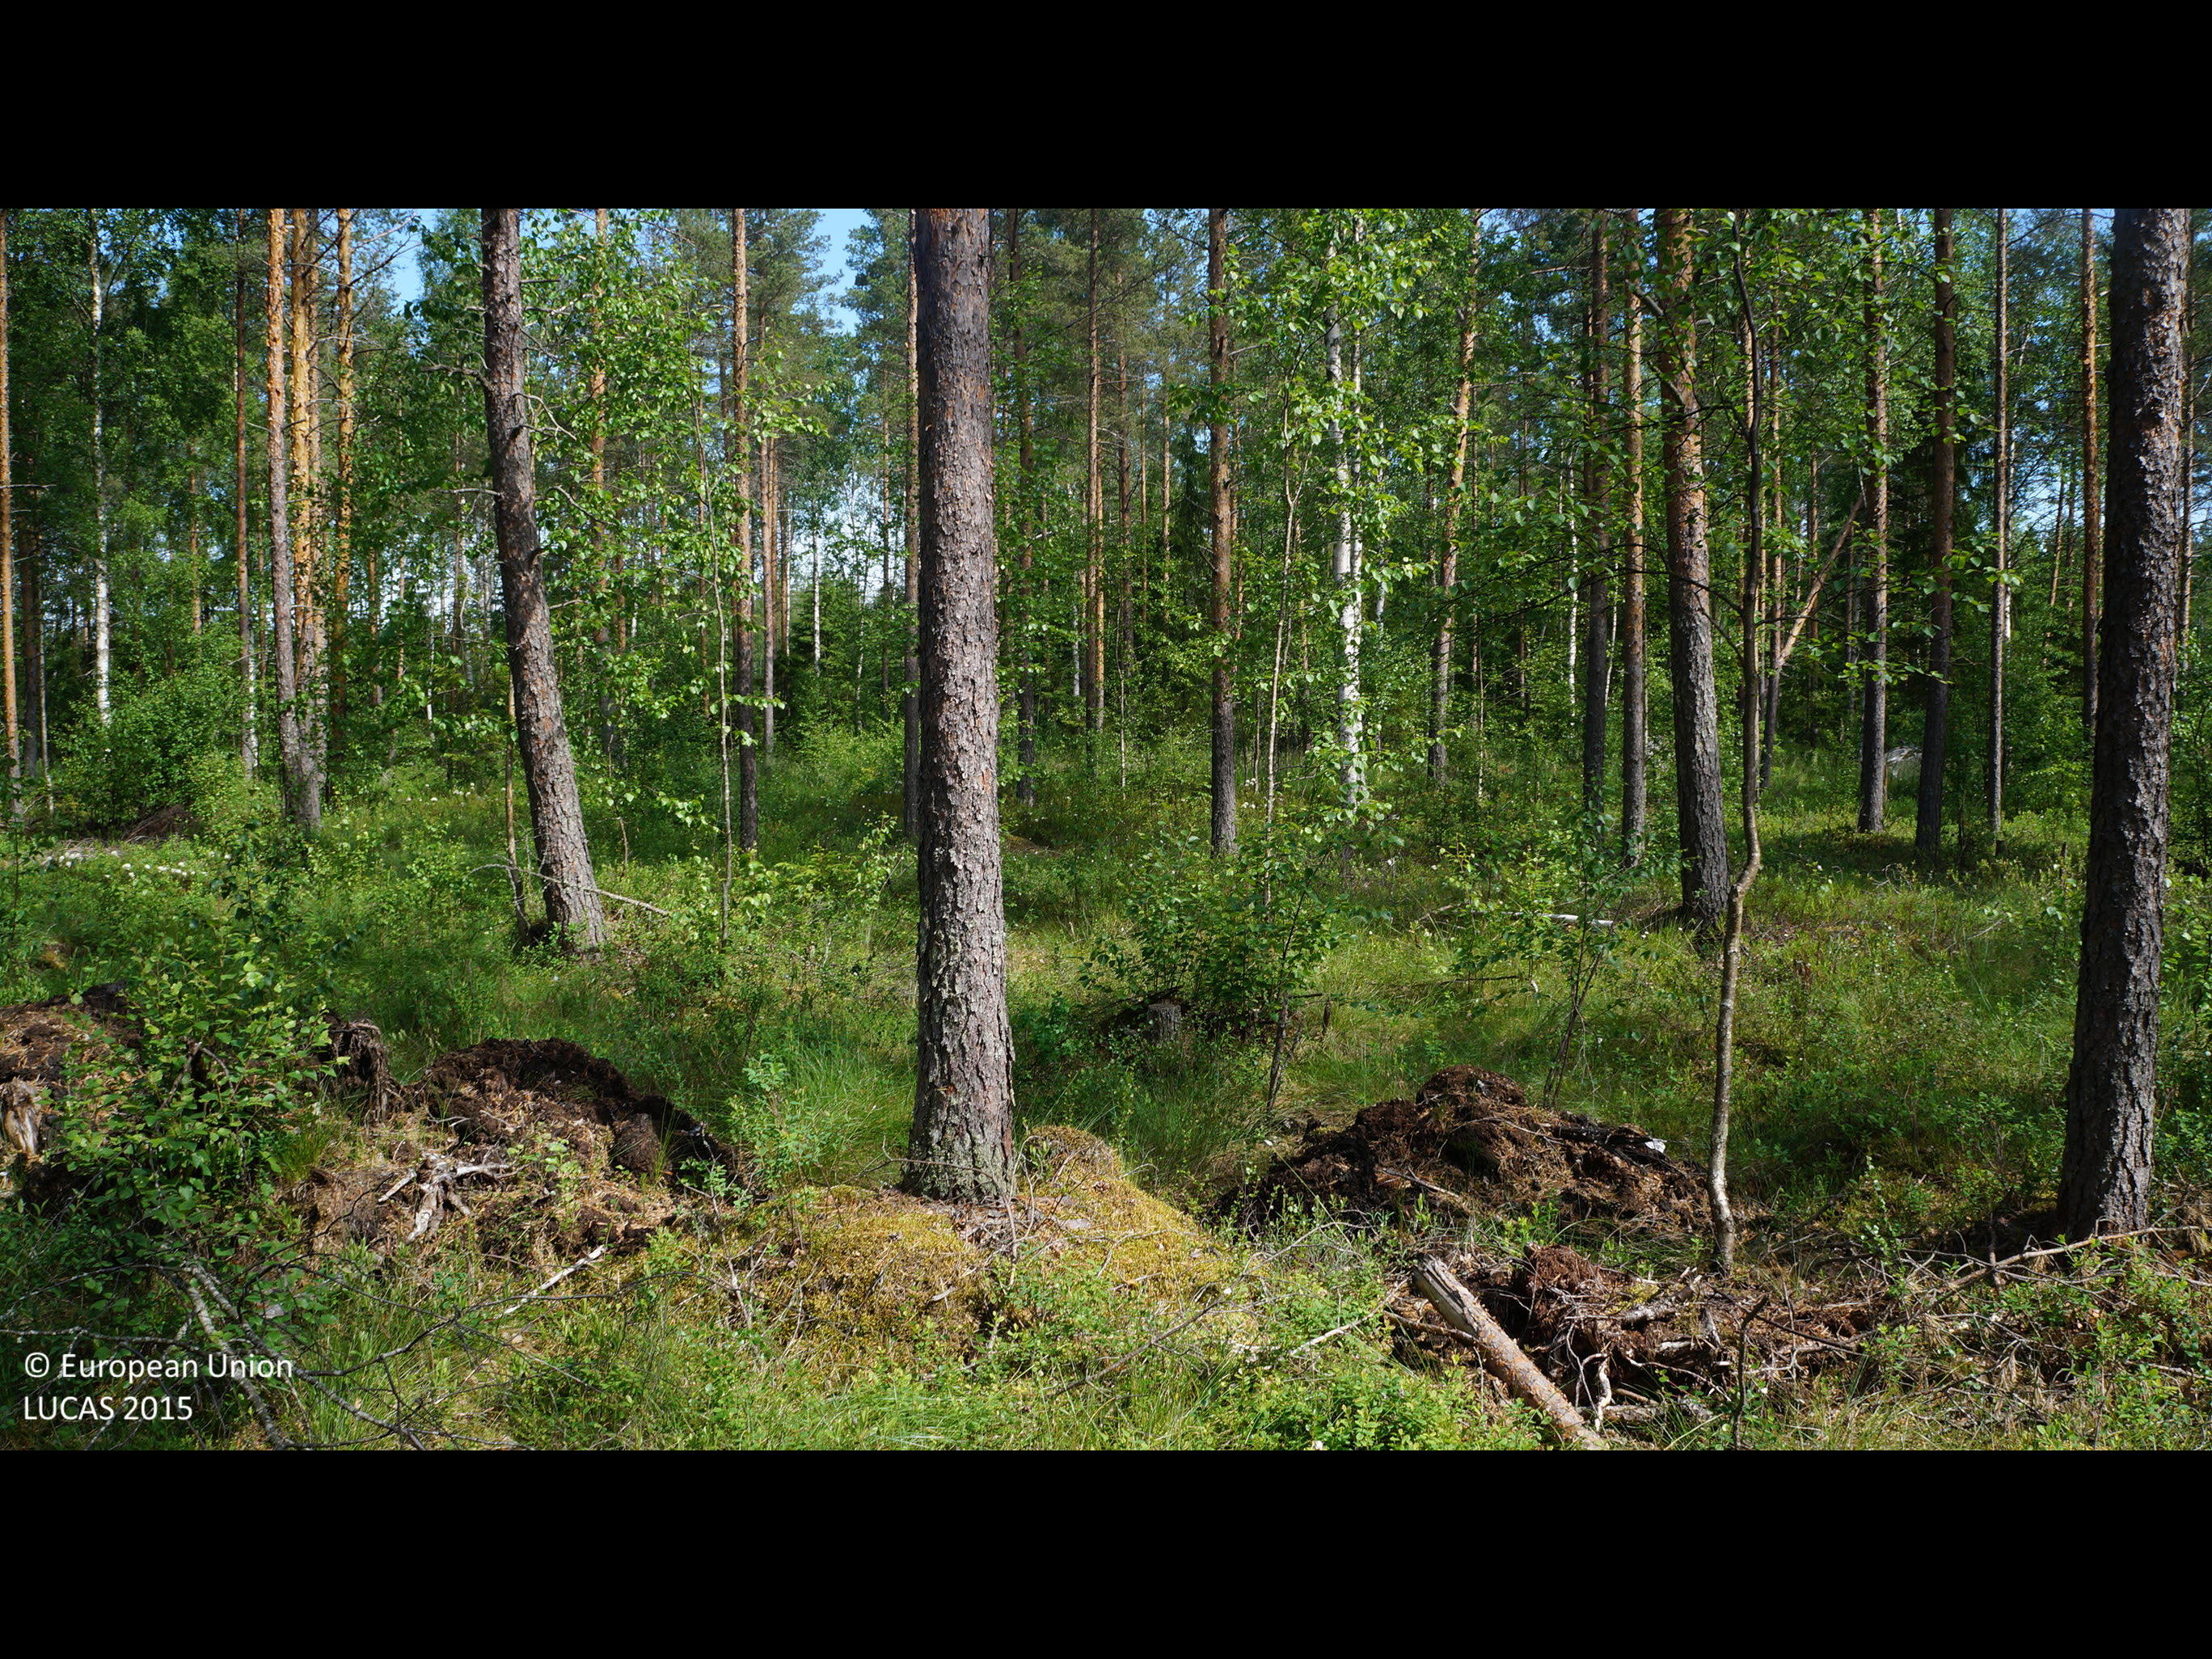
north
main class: Woodland
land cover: Pine dominated coniferous woodland
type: boreal forest
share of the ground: 50 - 75 %
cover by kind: coniferous forest trees 60 %, shrubs 20 %, broadleaved forest trees 10 %, herbaceous plants 5 %, lichens and mosses 5 %
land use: Forestry
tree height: > 5 m
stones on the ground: < 10 %
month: June
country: FI
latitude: 64.0980
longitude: 23.8705
